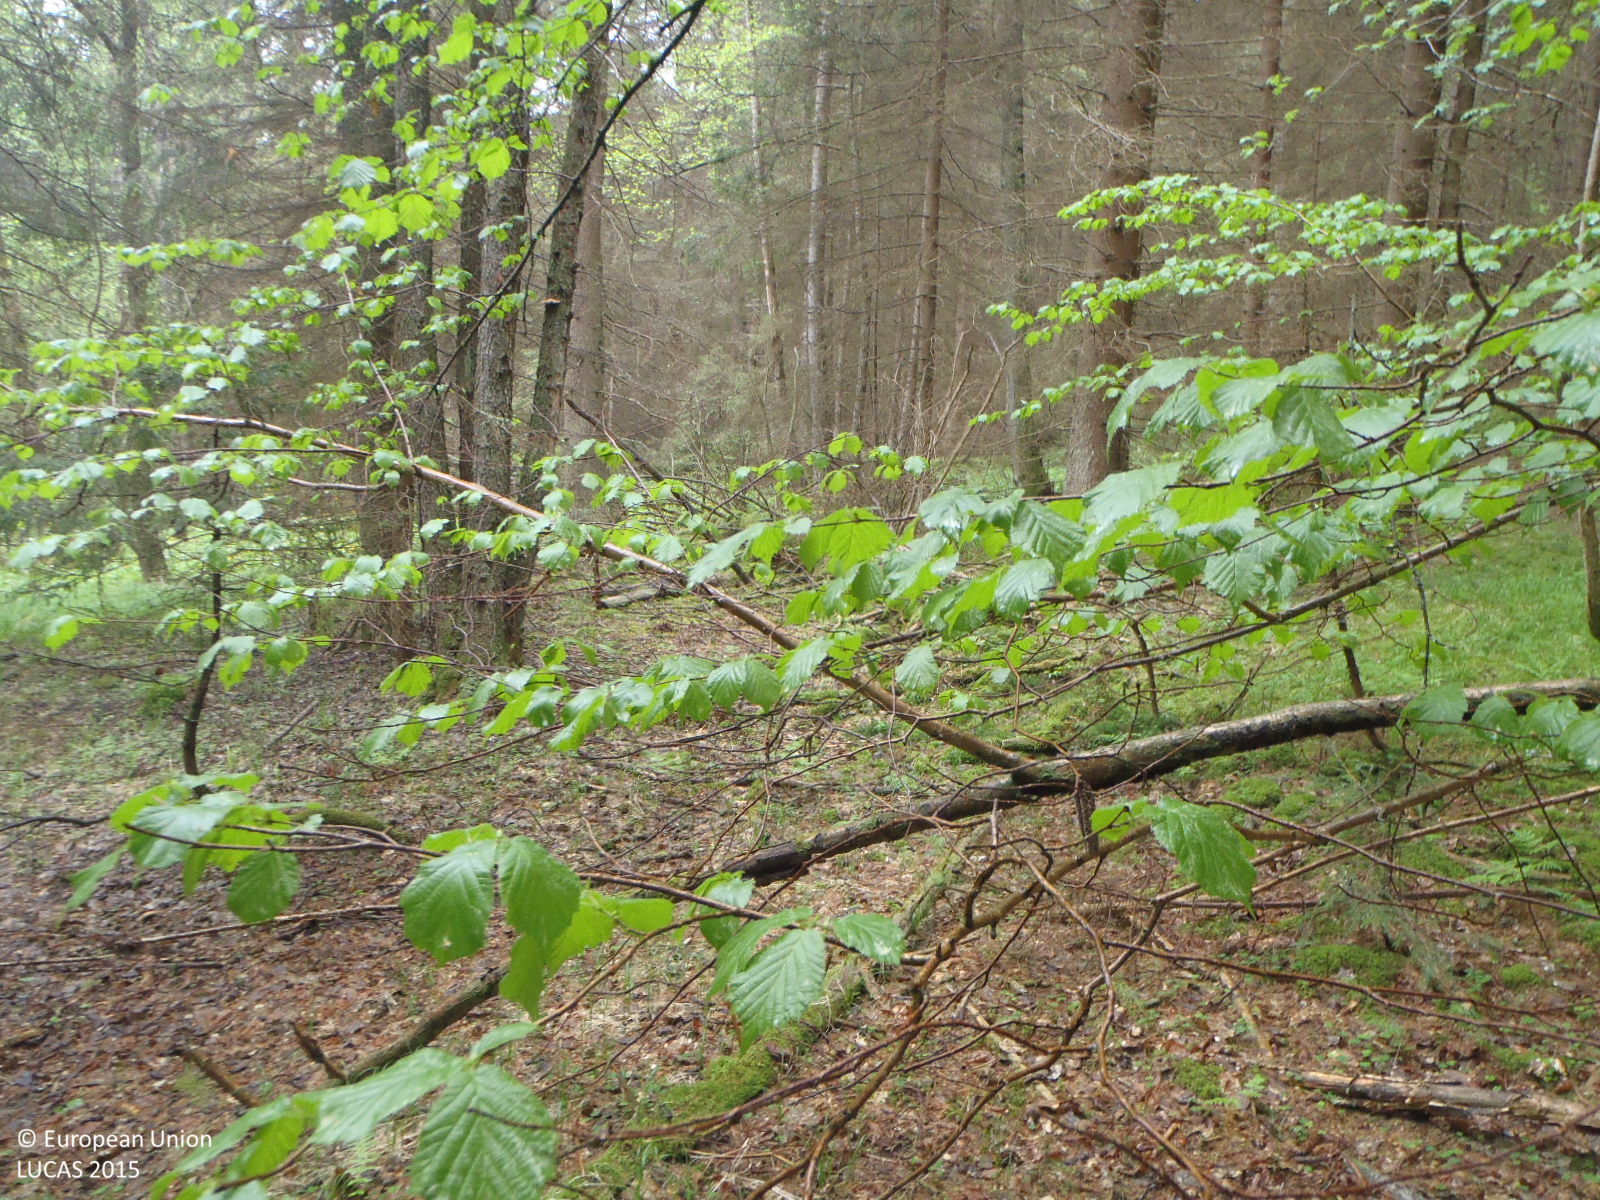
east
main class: Woodland
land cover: Spruce dominated mixed woodland
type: mire and swamp forests
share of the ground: > 75 %
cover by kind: coniferous forest trees 40 %, broadleaved forest trees 40 %, herbaceous plants 10 %, lichens and mosses 5 %, unconsolidated bare surface 5 %
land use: Forestry
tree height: > 5 m
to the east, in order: Spruce dominated mixed woodland; Rivers and streams; Spruce dominated coniferous woodland; Pine dominated coniferous woodland; Paved roads, cycling and walking lanes; Pine dominated coniferous woodland
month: May
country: CZ
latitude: 48.7318
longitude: 14.3650
